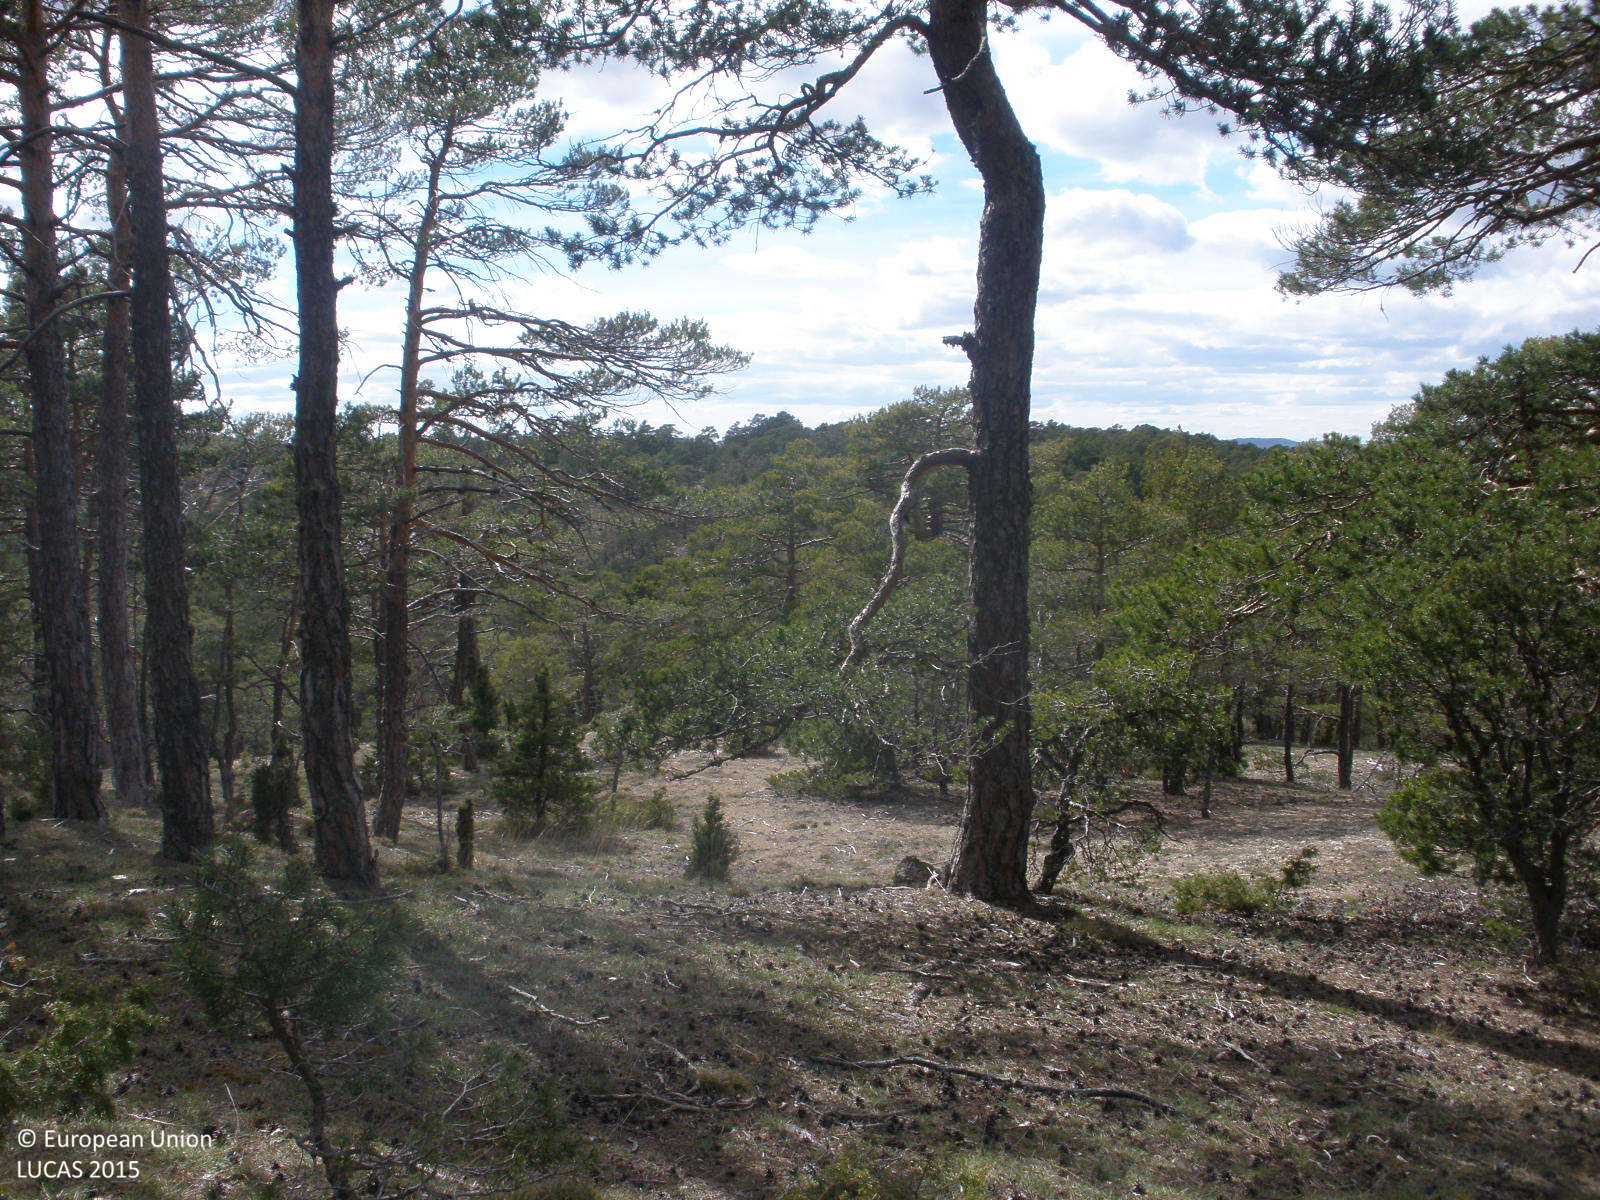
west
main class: Woodland
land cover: Pine dominated coniferous woodland
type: coniferous forest of the mediterranean region
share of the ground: 50 - 75 %
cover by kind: coniferous forest trees 70 %, herbaceous plants 20 %, shrubs 10 %
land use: Forestry
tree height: > 5 m
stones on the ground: < 10 %
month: April
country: ES
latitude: 40.3999
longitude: -0.7899
